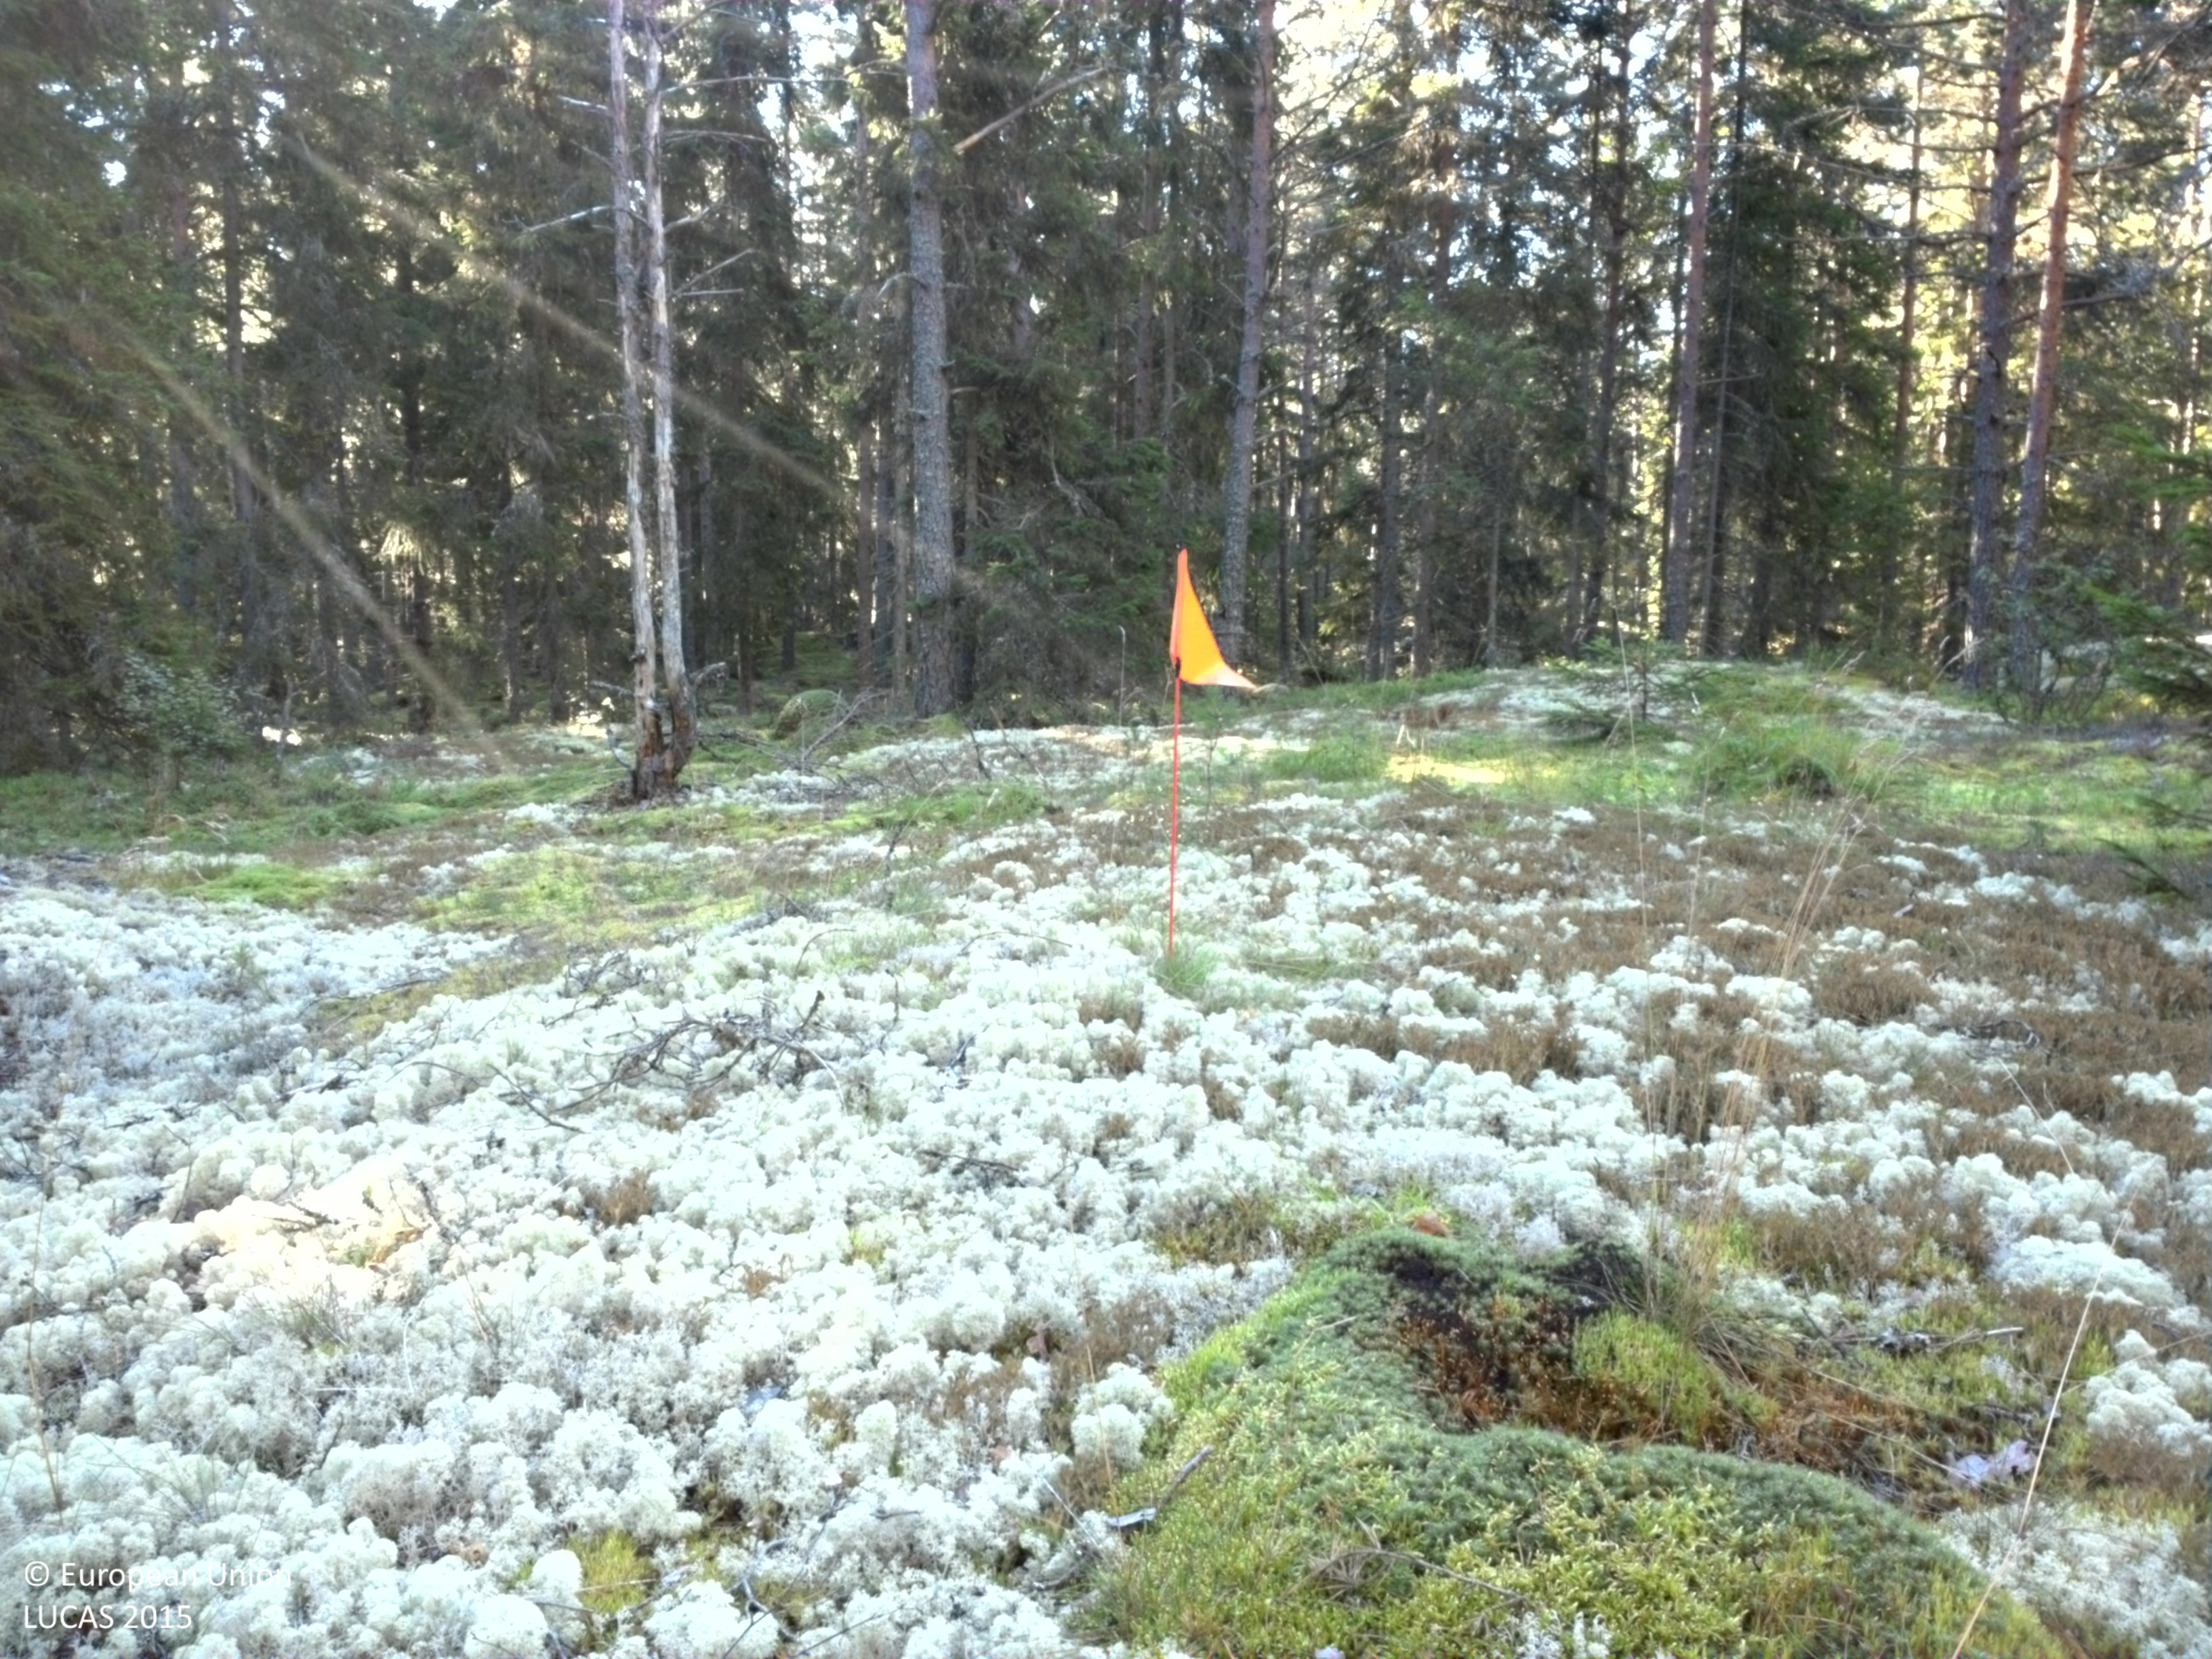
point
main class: Woodland
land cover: Pine dominated coniferous woodland
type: boreal forest
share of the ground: 50 - 75 %
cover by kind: coniferous forest trees 65 %, lichens and mosses 25 %, shrubs 10 %
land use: Forestry
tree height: > 5 m
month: August
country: SE
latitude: 59.7775
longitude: 17.2423
